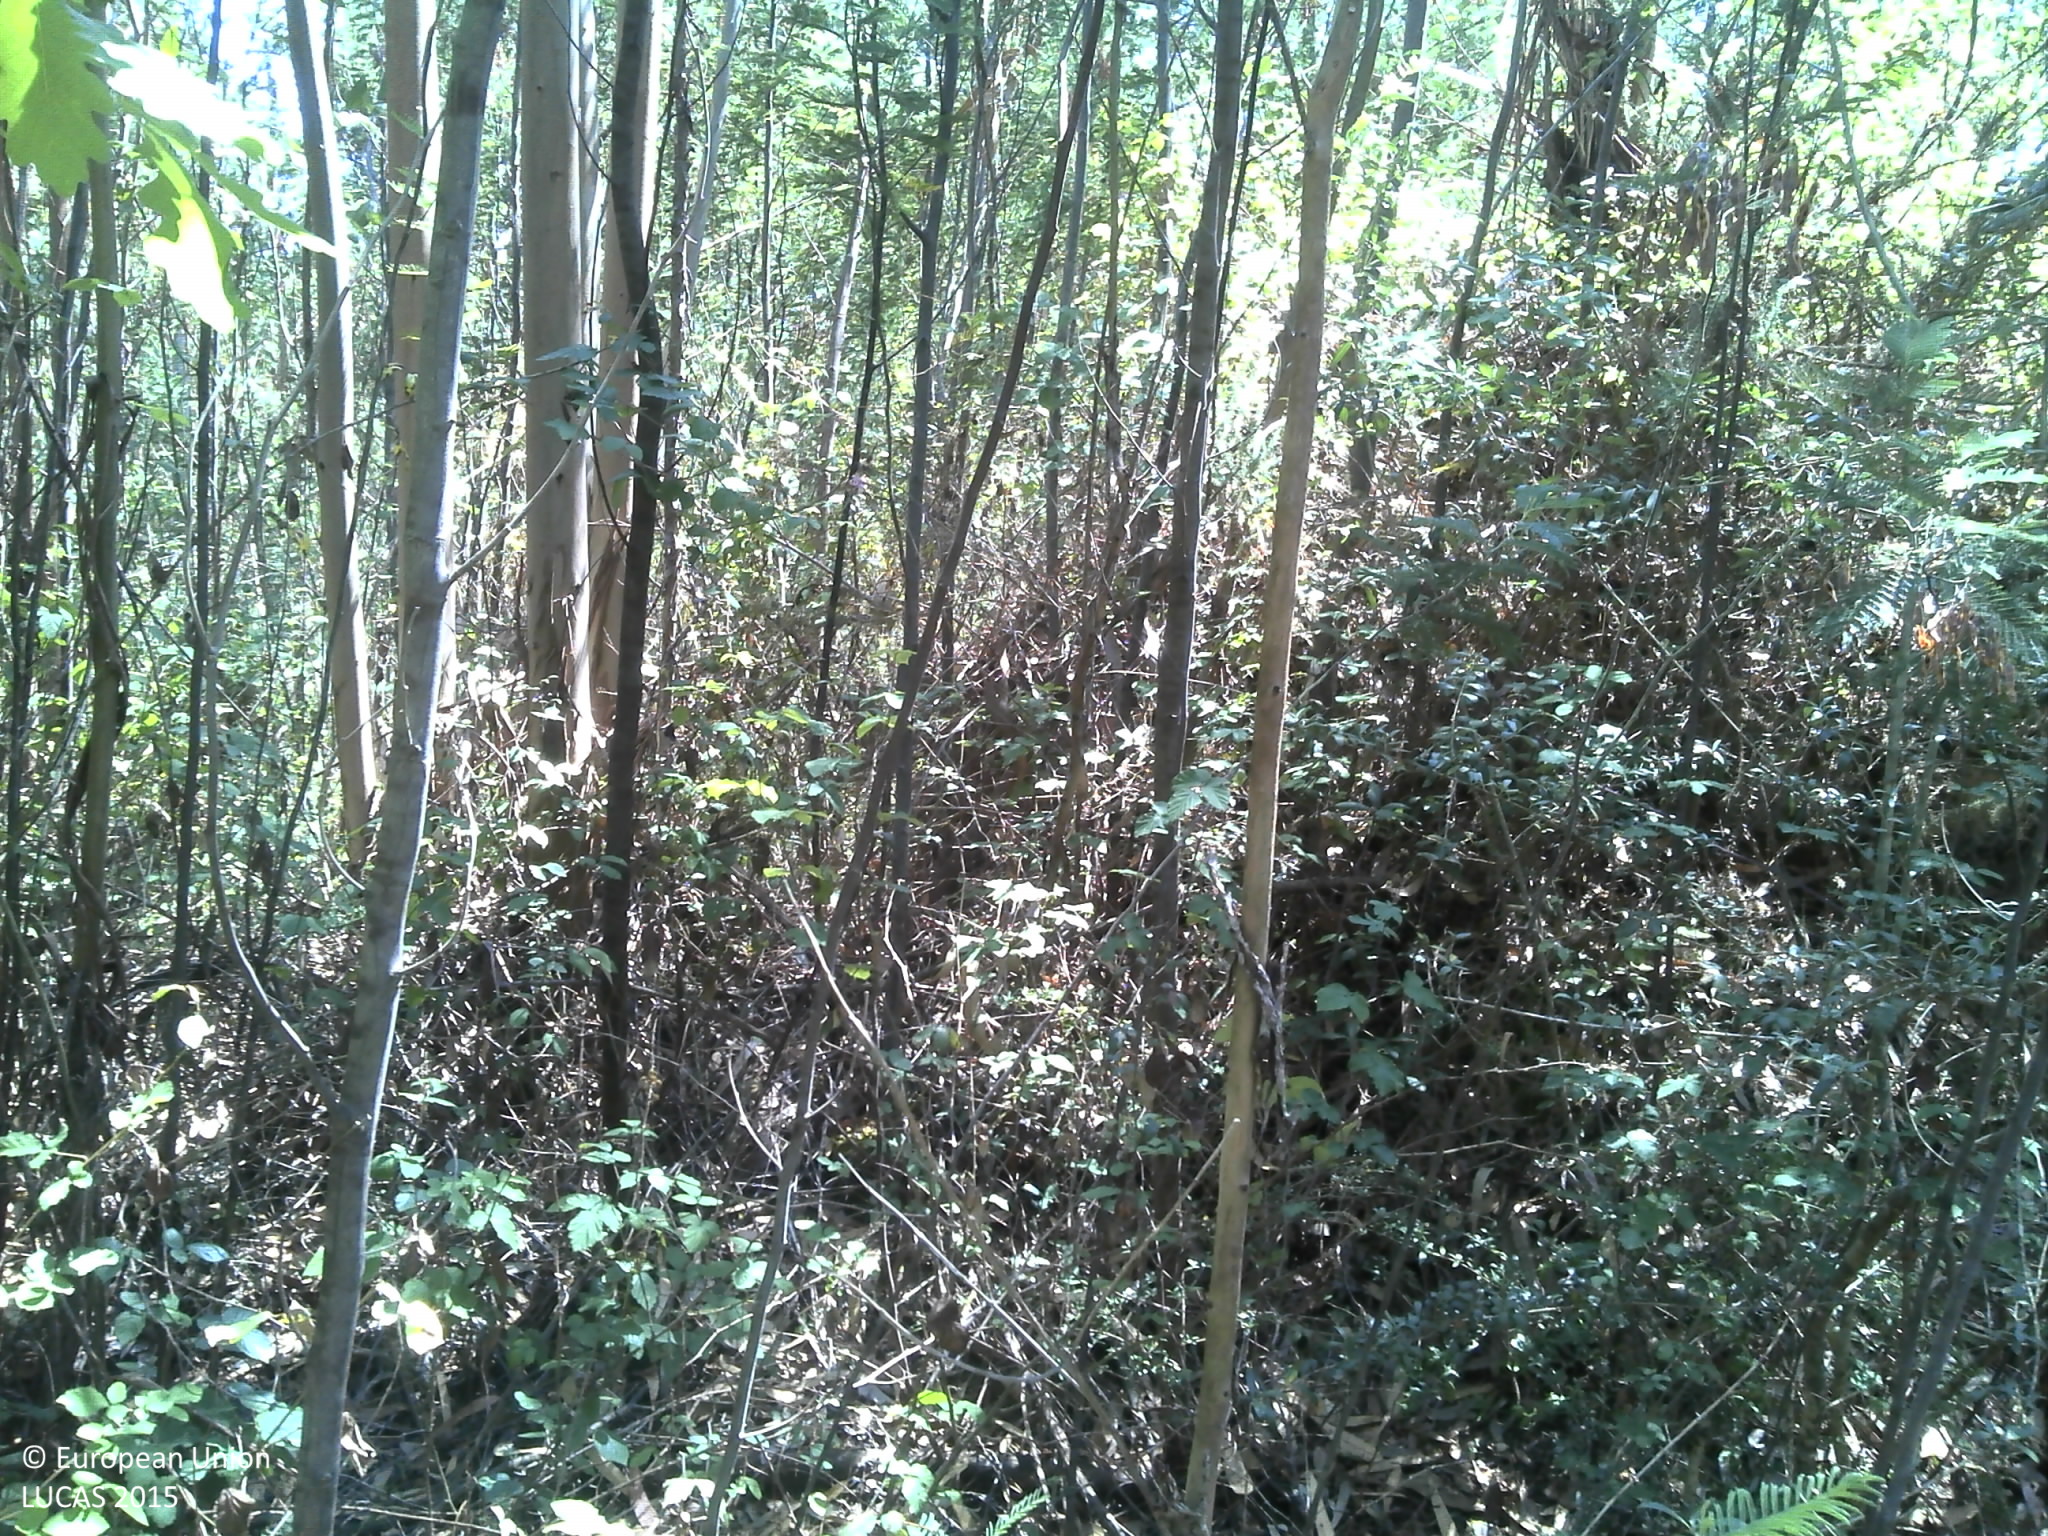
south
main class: Woodland
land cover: Broadleaved woodland
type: exotic forest
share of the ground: > 75 %
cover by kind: broadleaved forest trees 75 %, shrubs 15 %, unconsolidated bare surface 10 %
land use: Forestry
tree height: > 5 m
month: July
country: PT
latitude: 40.2112
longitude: -8.2070
